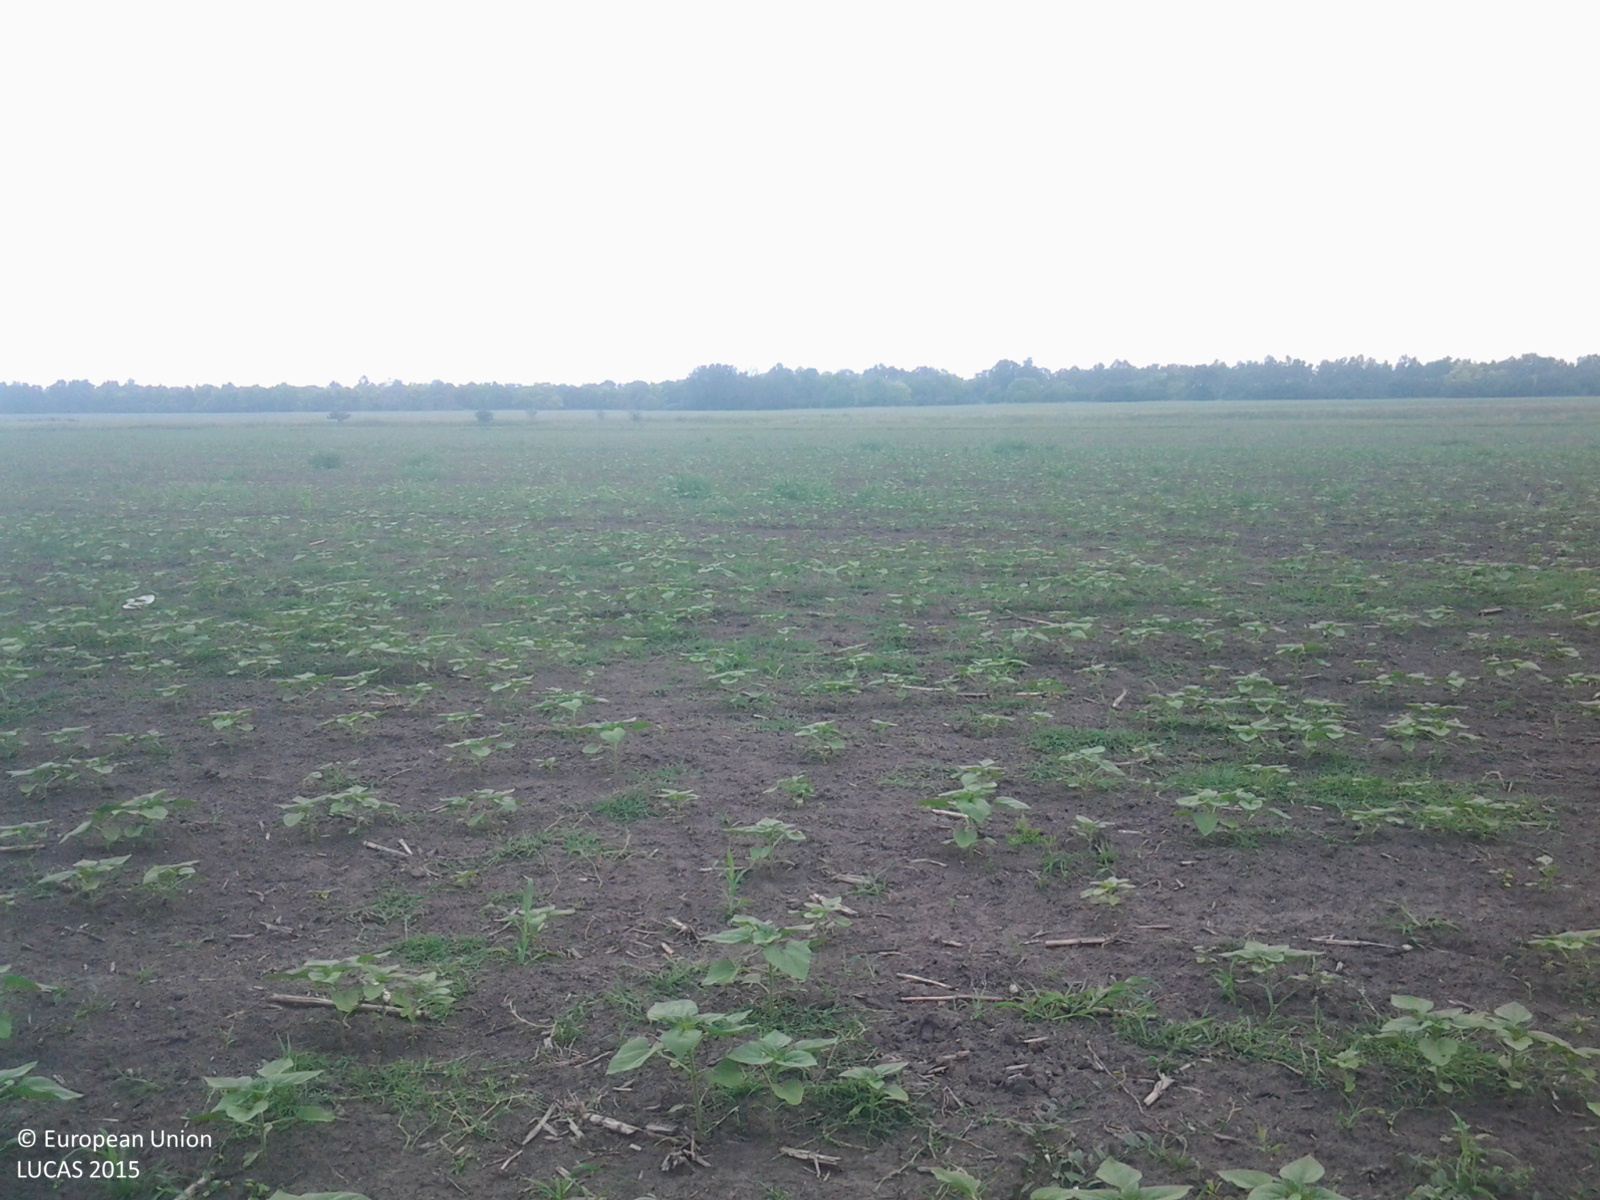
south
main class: Cropland
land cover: Sunflower
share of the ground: < 10 %
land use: Agriculture (excluding fallow land and kitchen gardens)
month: June
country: HU
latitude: 46.8821
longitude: 19.7712
